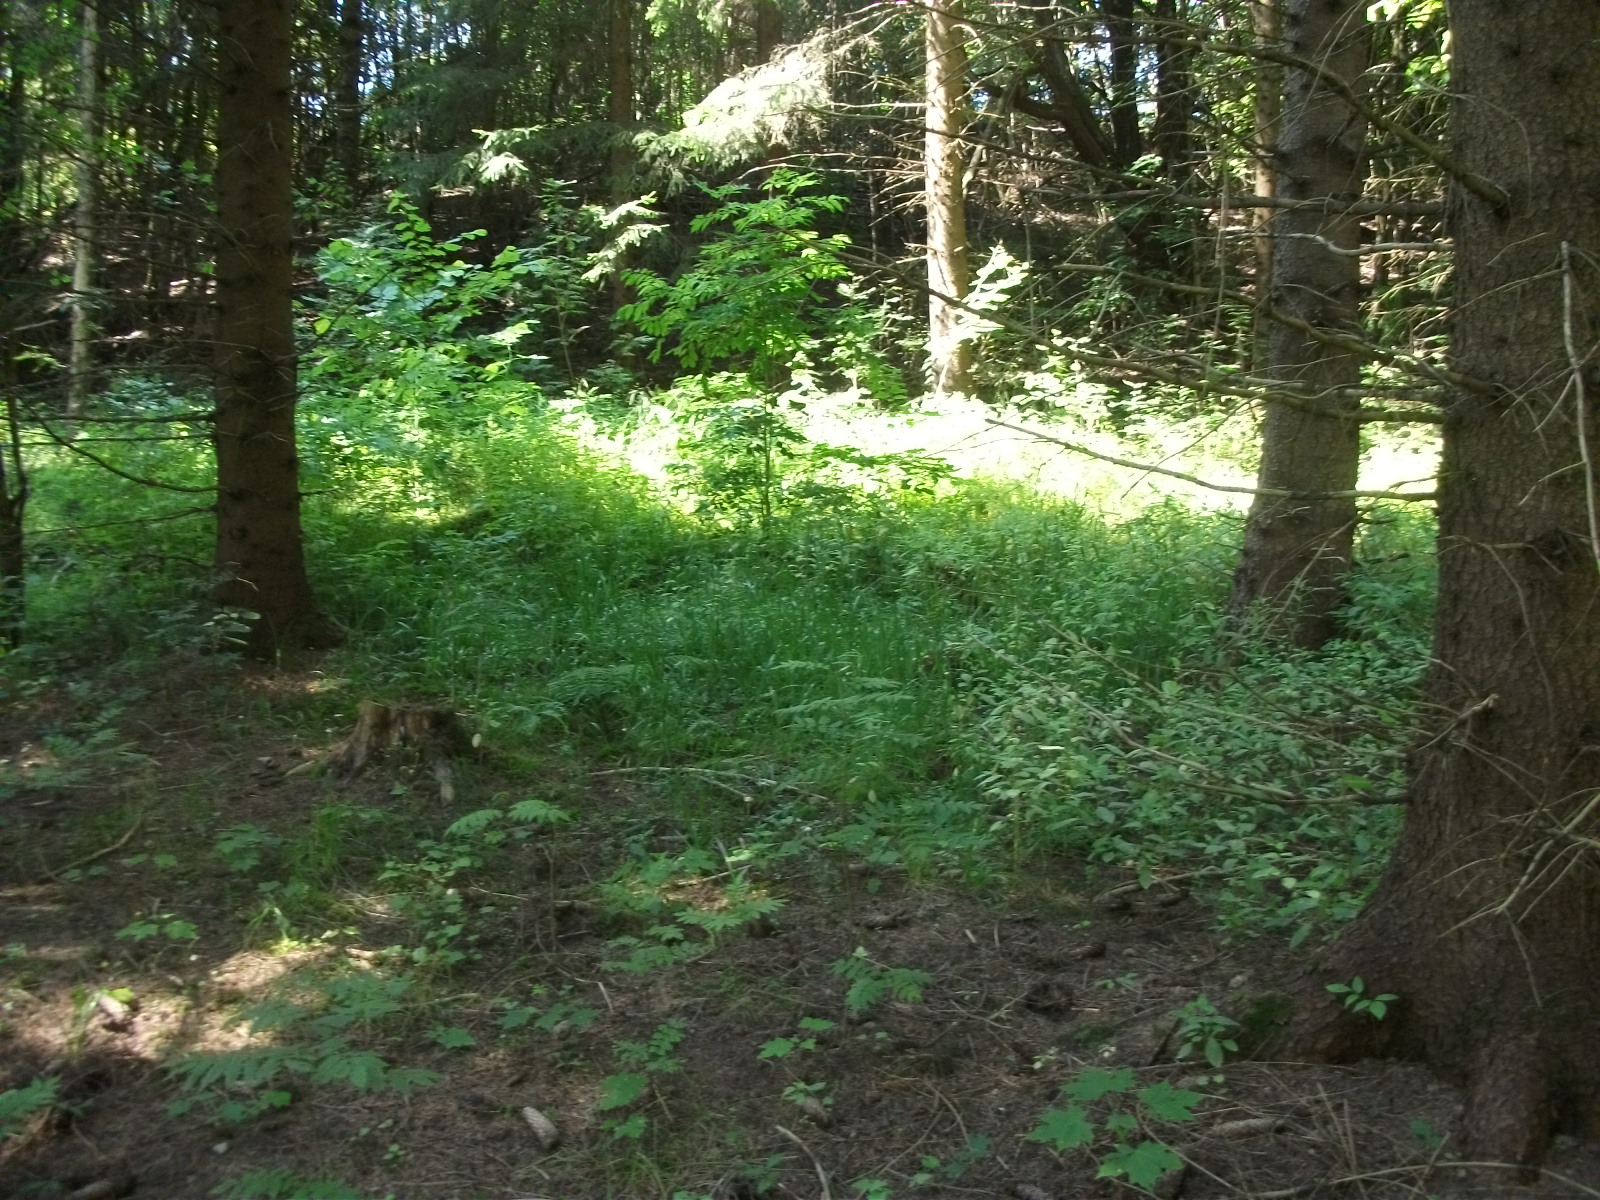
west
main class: Woodland
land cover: Spruce dominated coniferous woodland
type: hemiboreal forest and nemoral coniferous forest and mixed broadleaved-coniferous forest
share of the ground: > 75 %
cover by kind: coniferous forest trees 85 %, herbaceous plants 5 %, lichens and mosses 5 %, unconsolidated bare surface 5 %
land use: Forestry
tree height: > 5 m
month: August
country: LV
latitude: 56.8799
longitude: 25.7301
